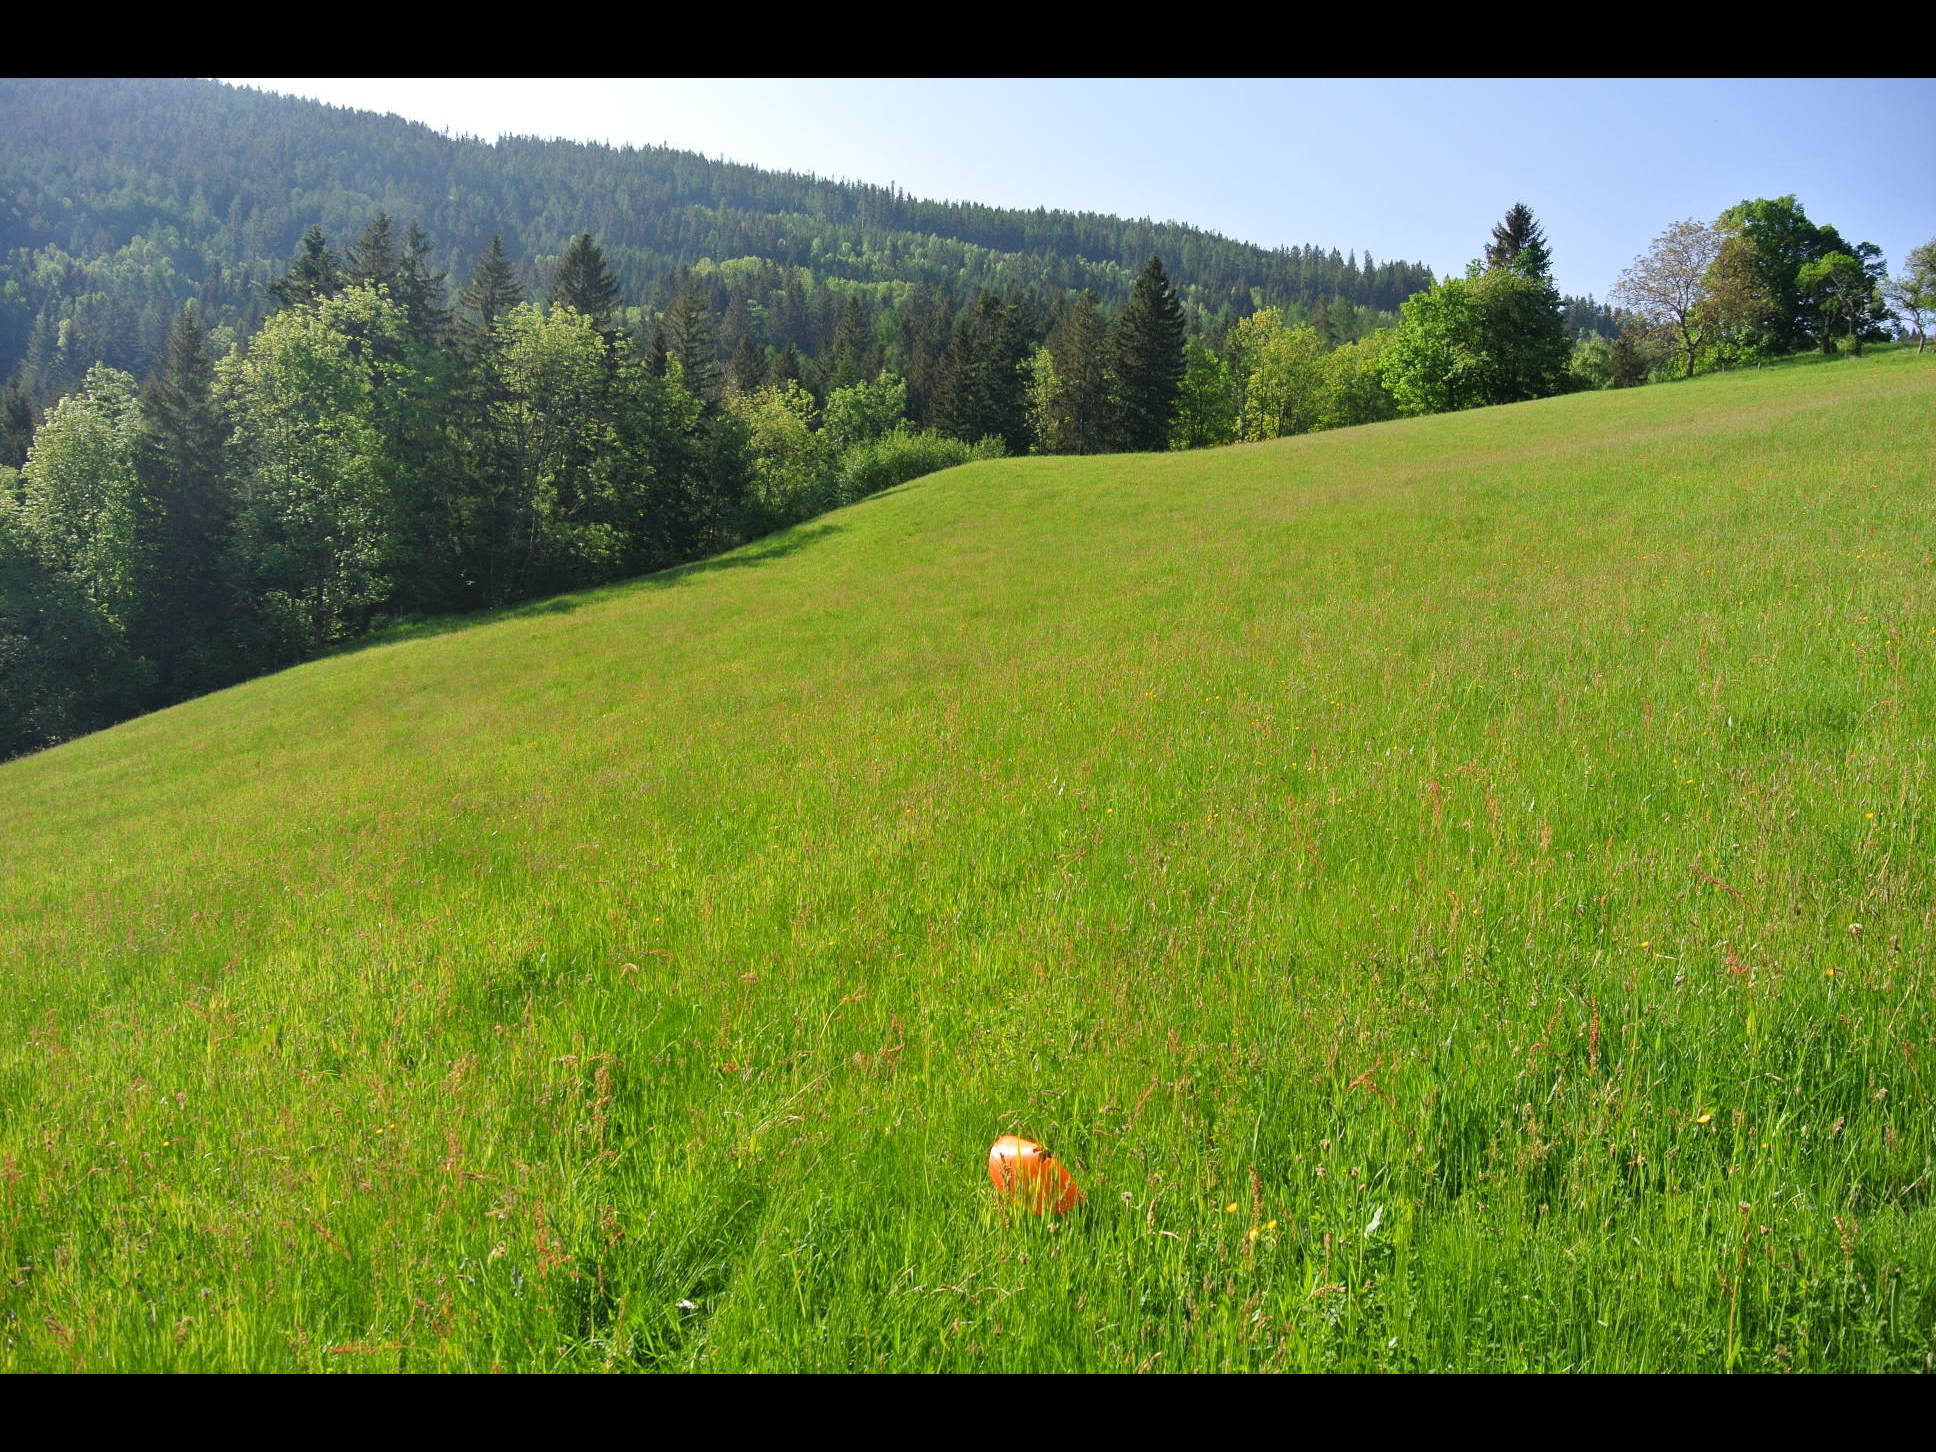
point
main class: Grassland
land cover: Grassland without tree/shrub cover
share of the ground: > 75 %
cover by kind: herbaceous plants 100 %
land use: Agriculture (excluding fallow land and kitchen gardens)
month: May
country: AT
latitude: 47.6741
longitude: 15.7959
